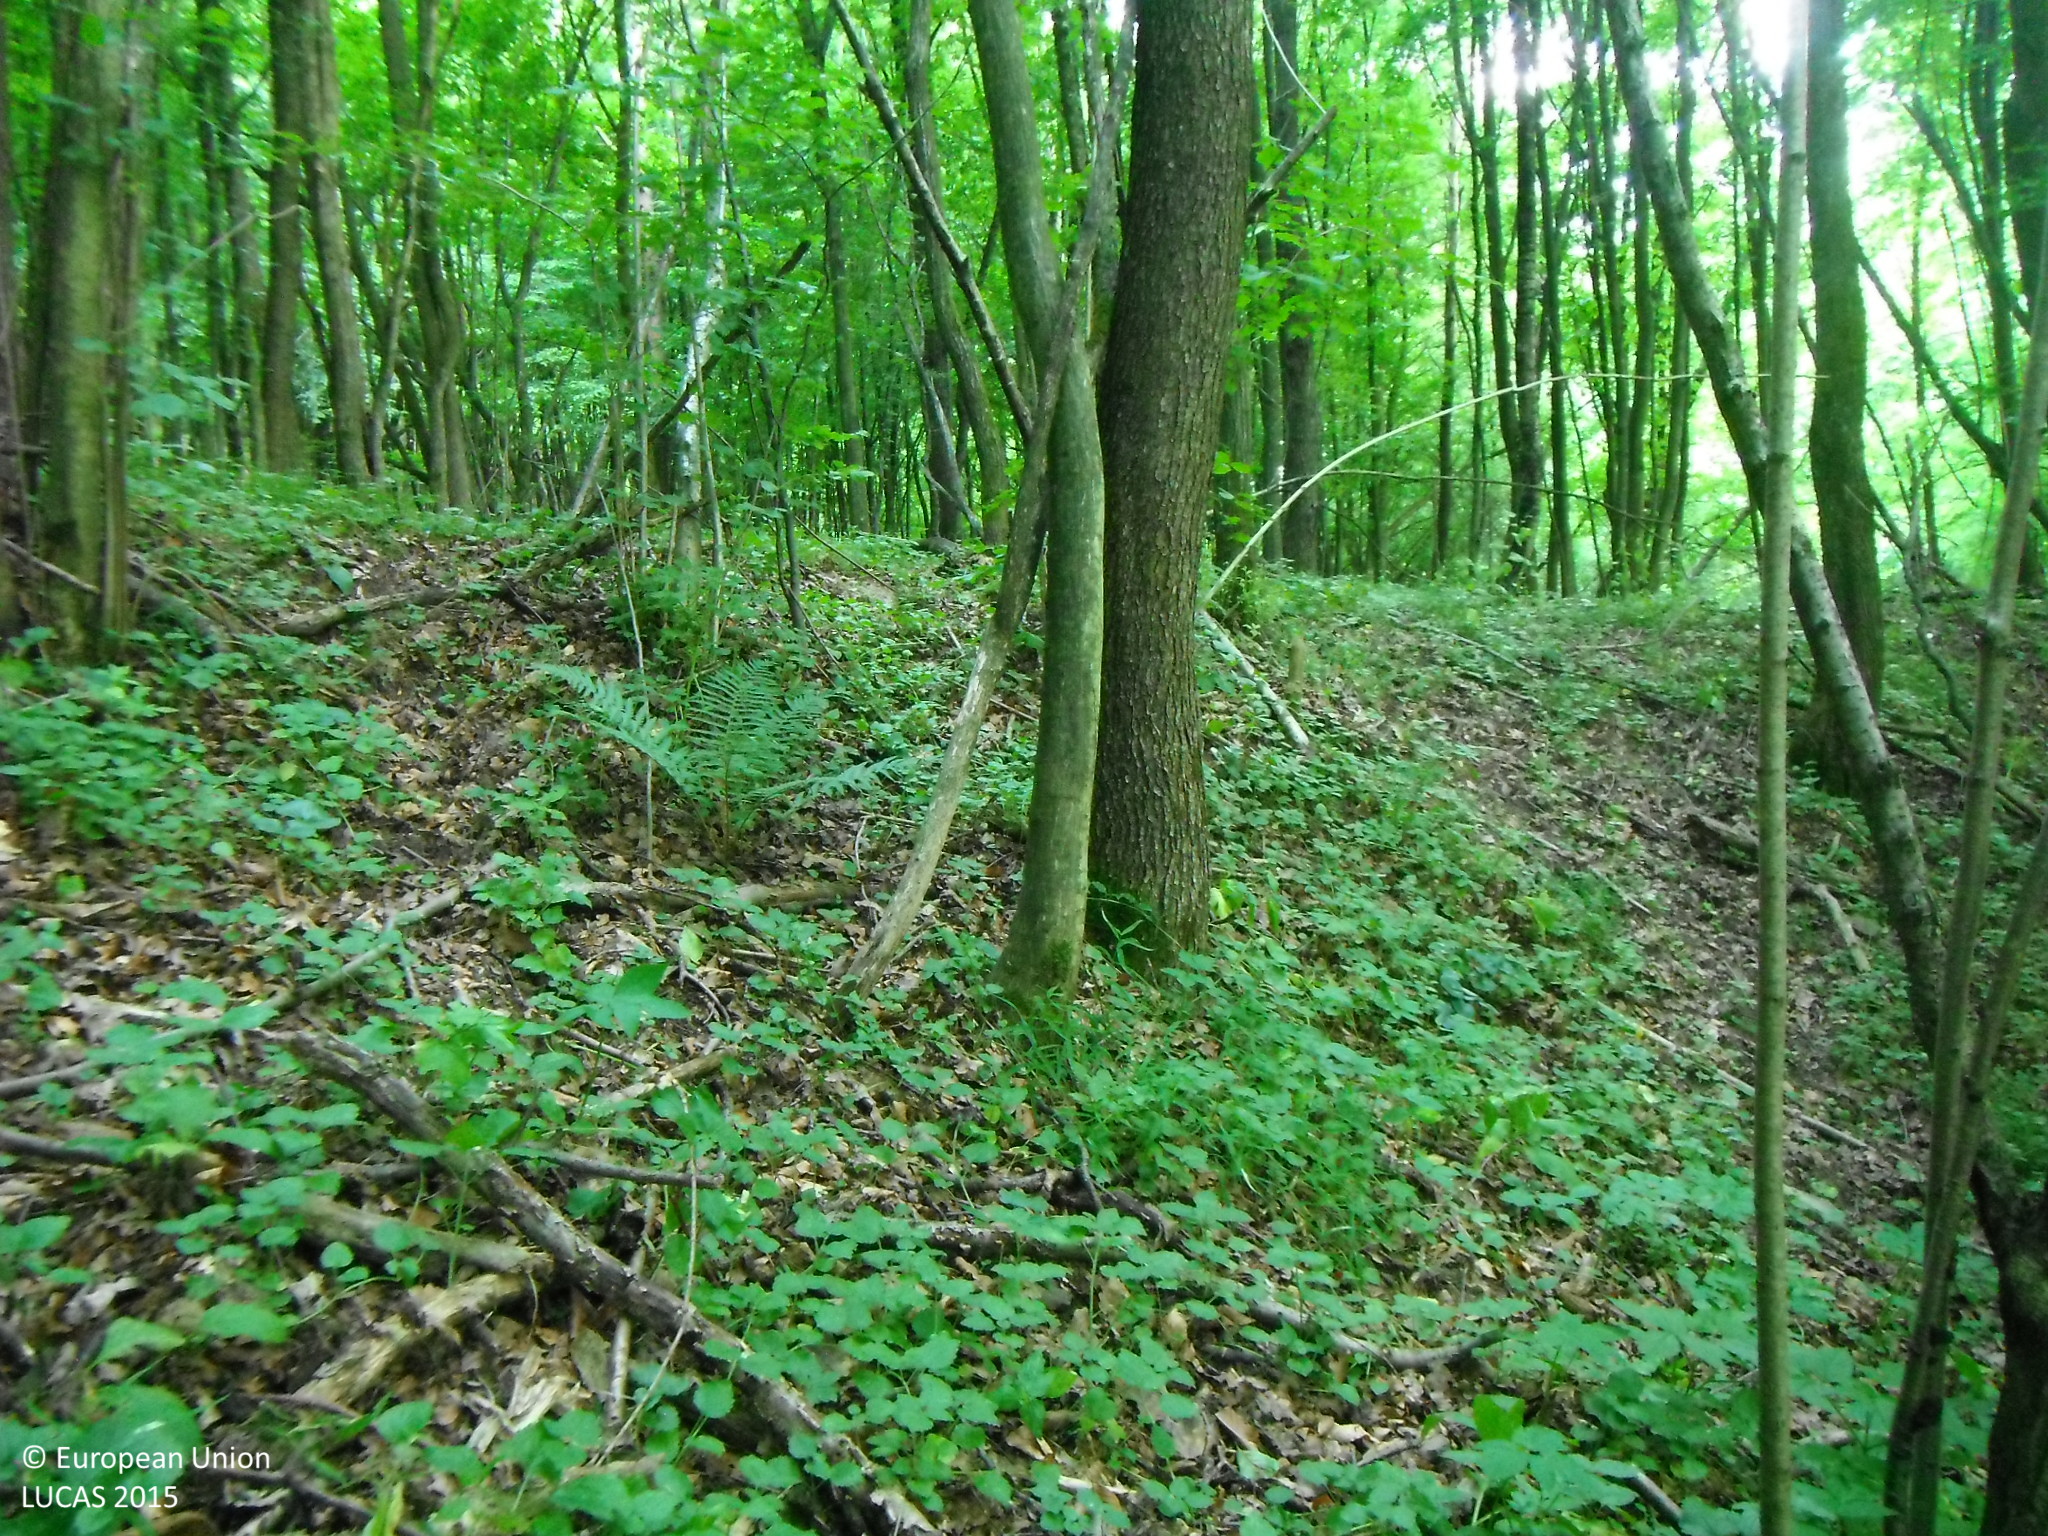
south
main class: Woodland
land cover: Broadleaved woodland
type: beech forest
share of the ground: > 75 %
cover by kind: broadleaved forest trees 100 %
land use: Forestry
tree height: > 5 m
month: July
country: SK
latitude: 49.0768
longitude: 21.8127
